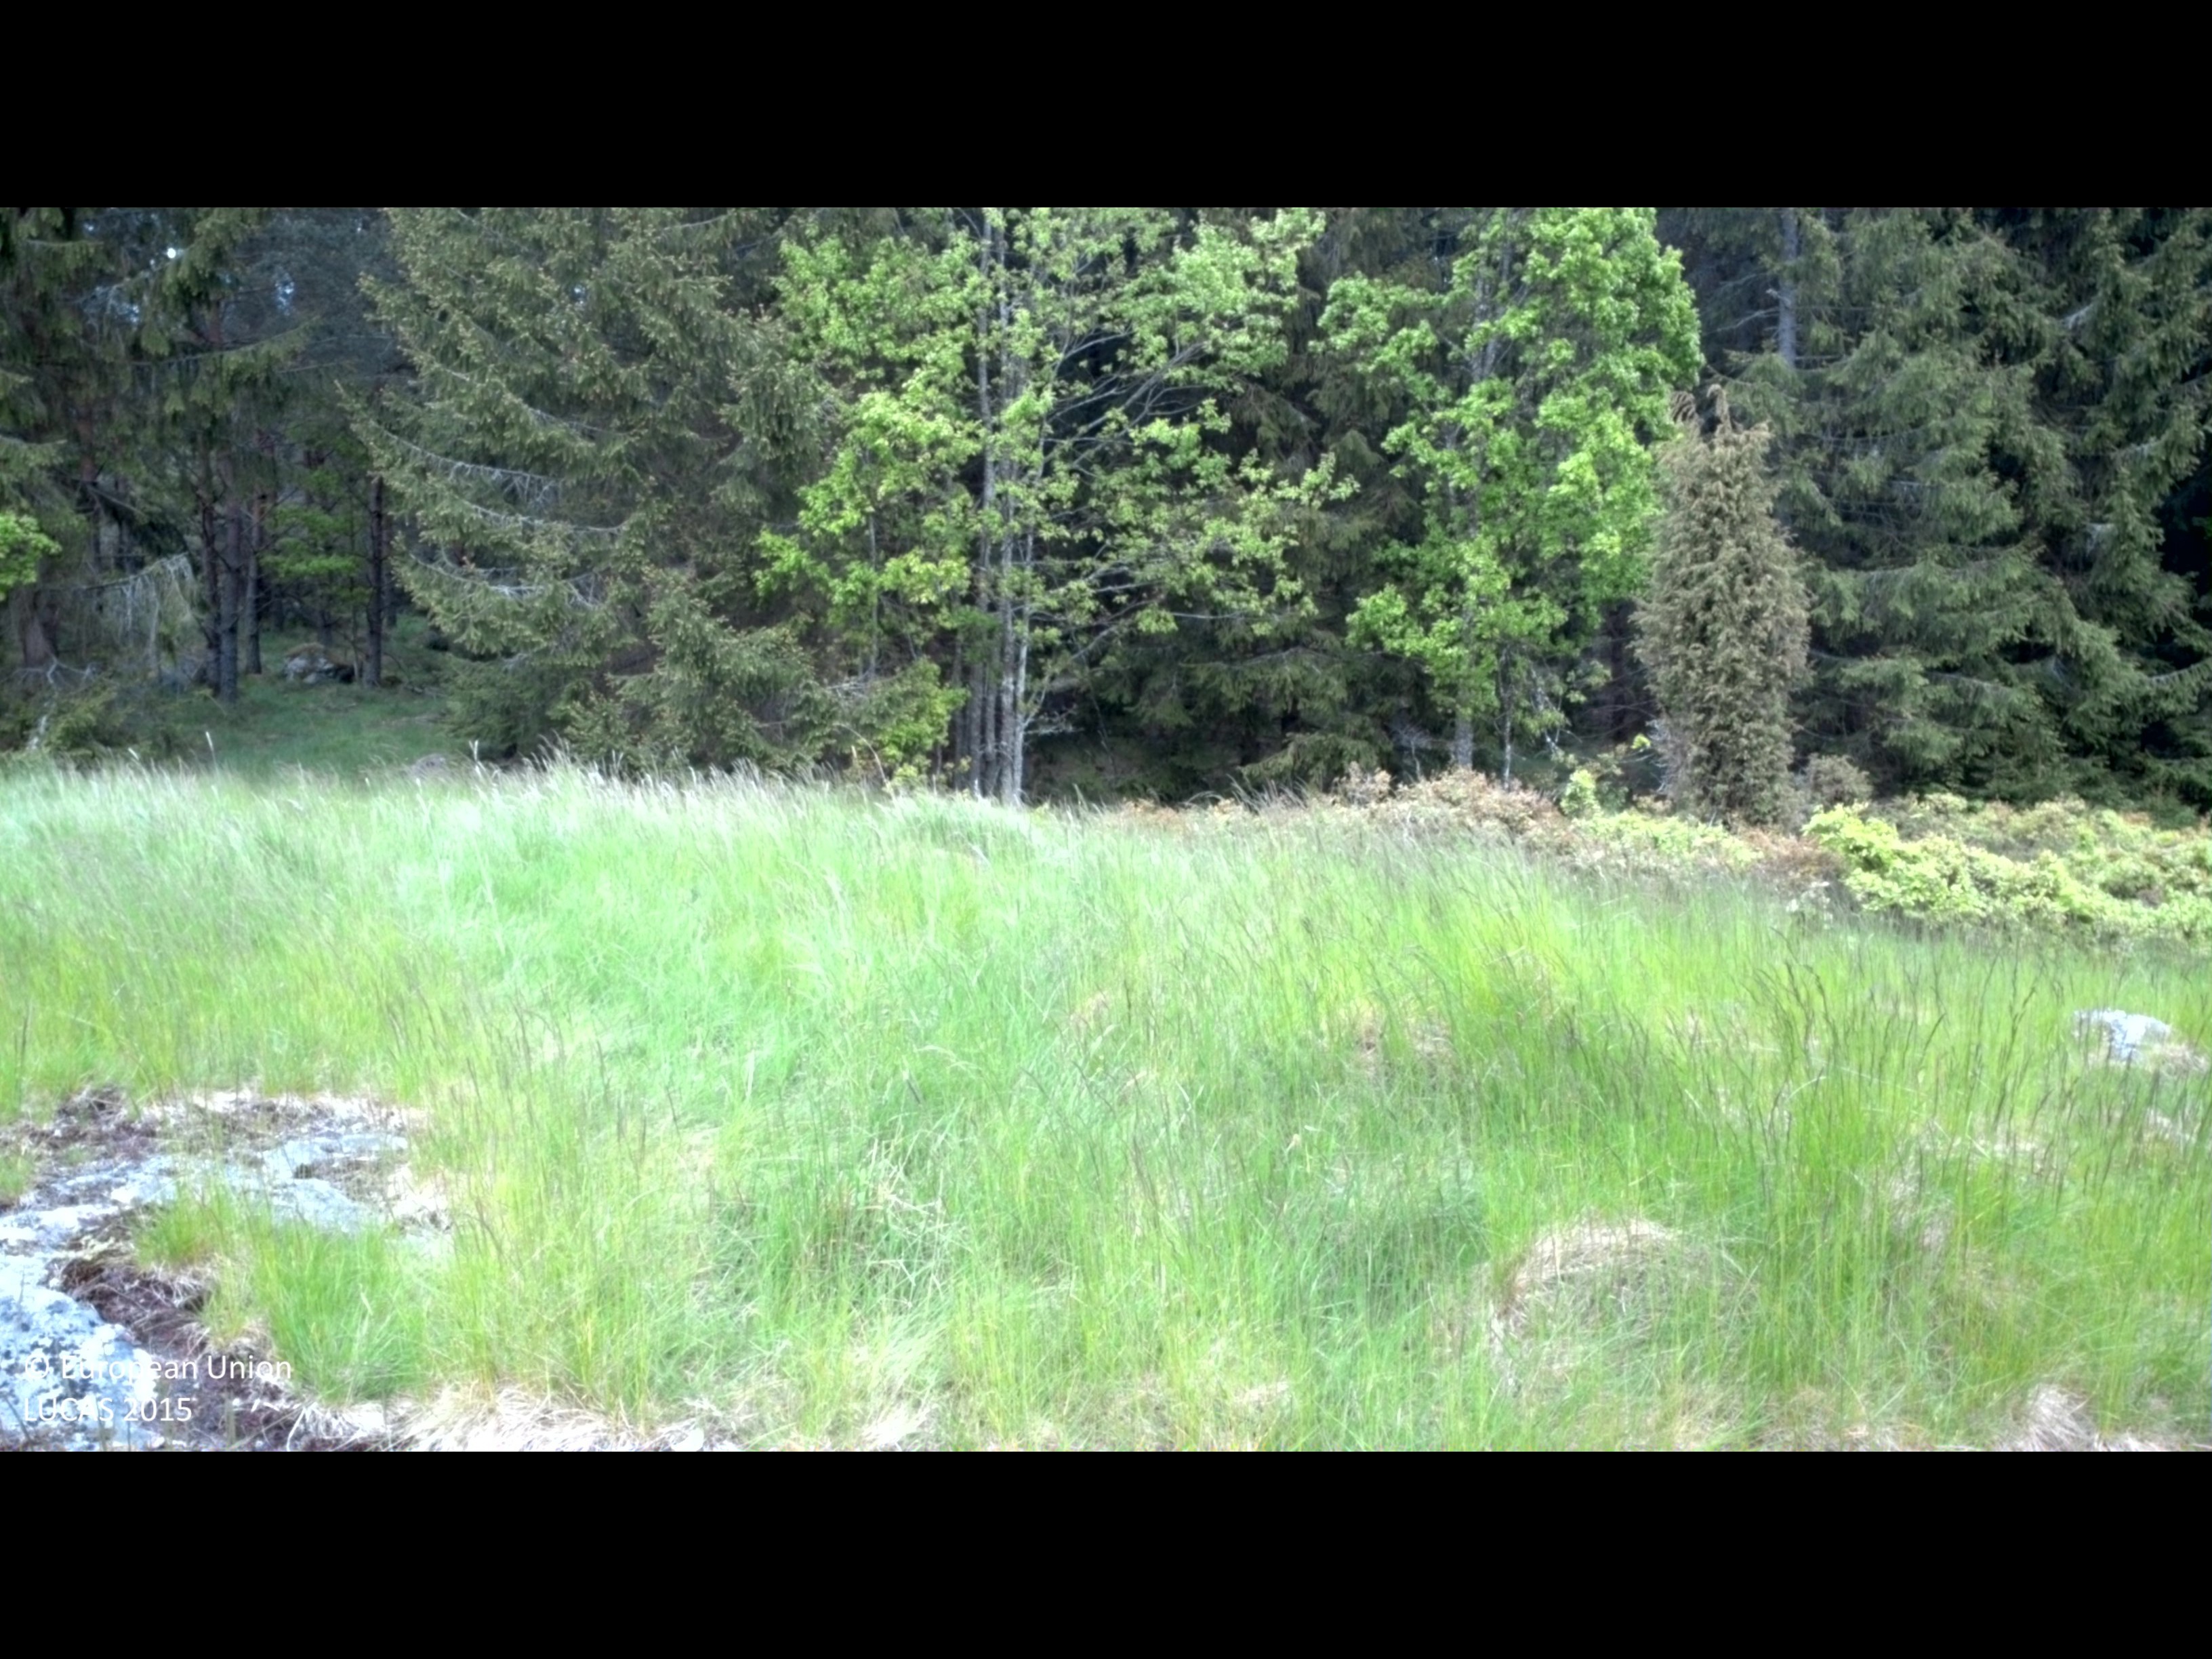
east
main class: Artificial land
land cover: Other artificial areas
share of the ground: > 75 %
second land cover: Grassland with sparse tree/shrub cover
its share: > 75 %
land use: Electricity, gas and thermal power distribution
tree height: > 5 m
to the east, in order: Artificial constructions in urban areas; Grassland with sparse tree/shrub cover; Spruce dominated coniferous woodland; Pine dominated coniferous woodland; Spruce dominated coniferous woodland; Pine dominated coniferous woodland; Pine dominated mixed woodland
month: June
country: SE
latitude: 57.7260
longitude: 16.3620
